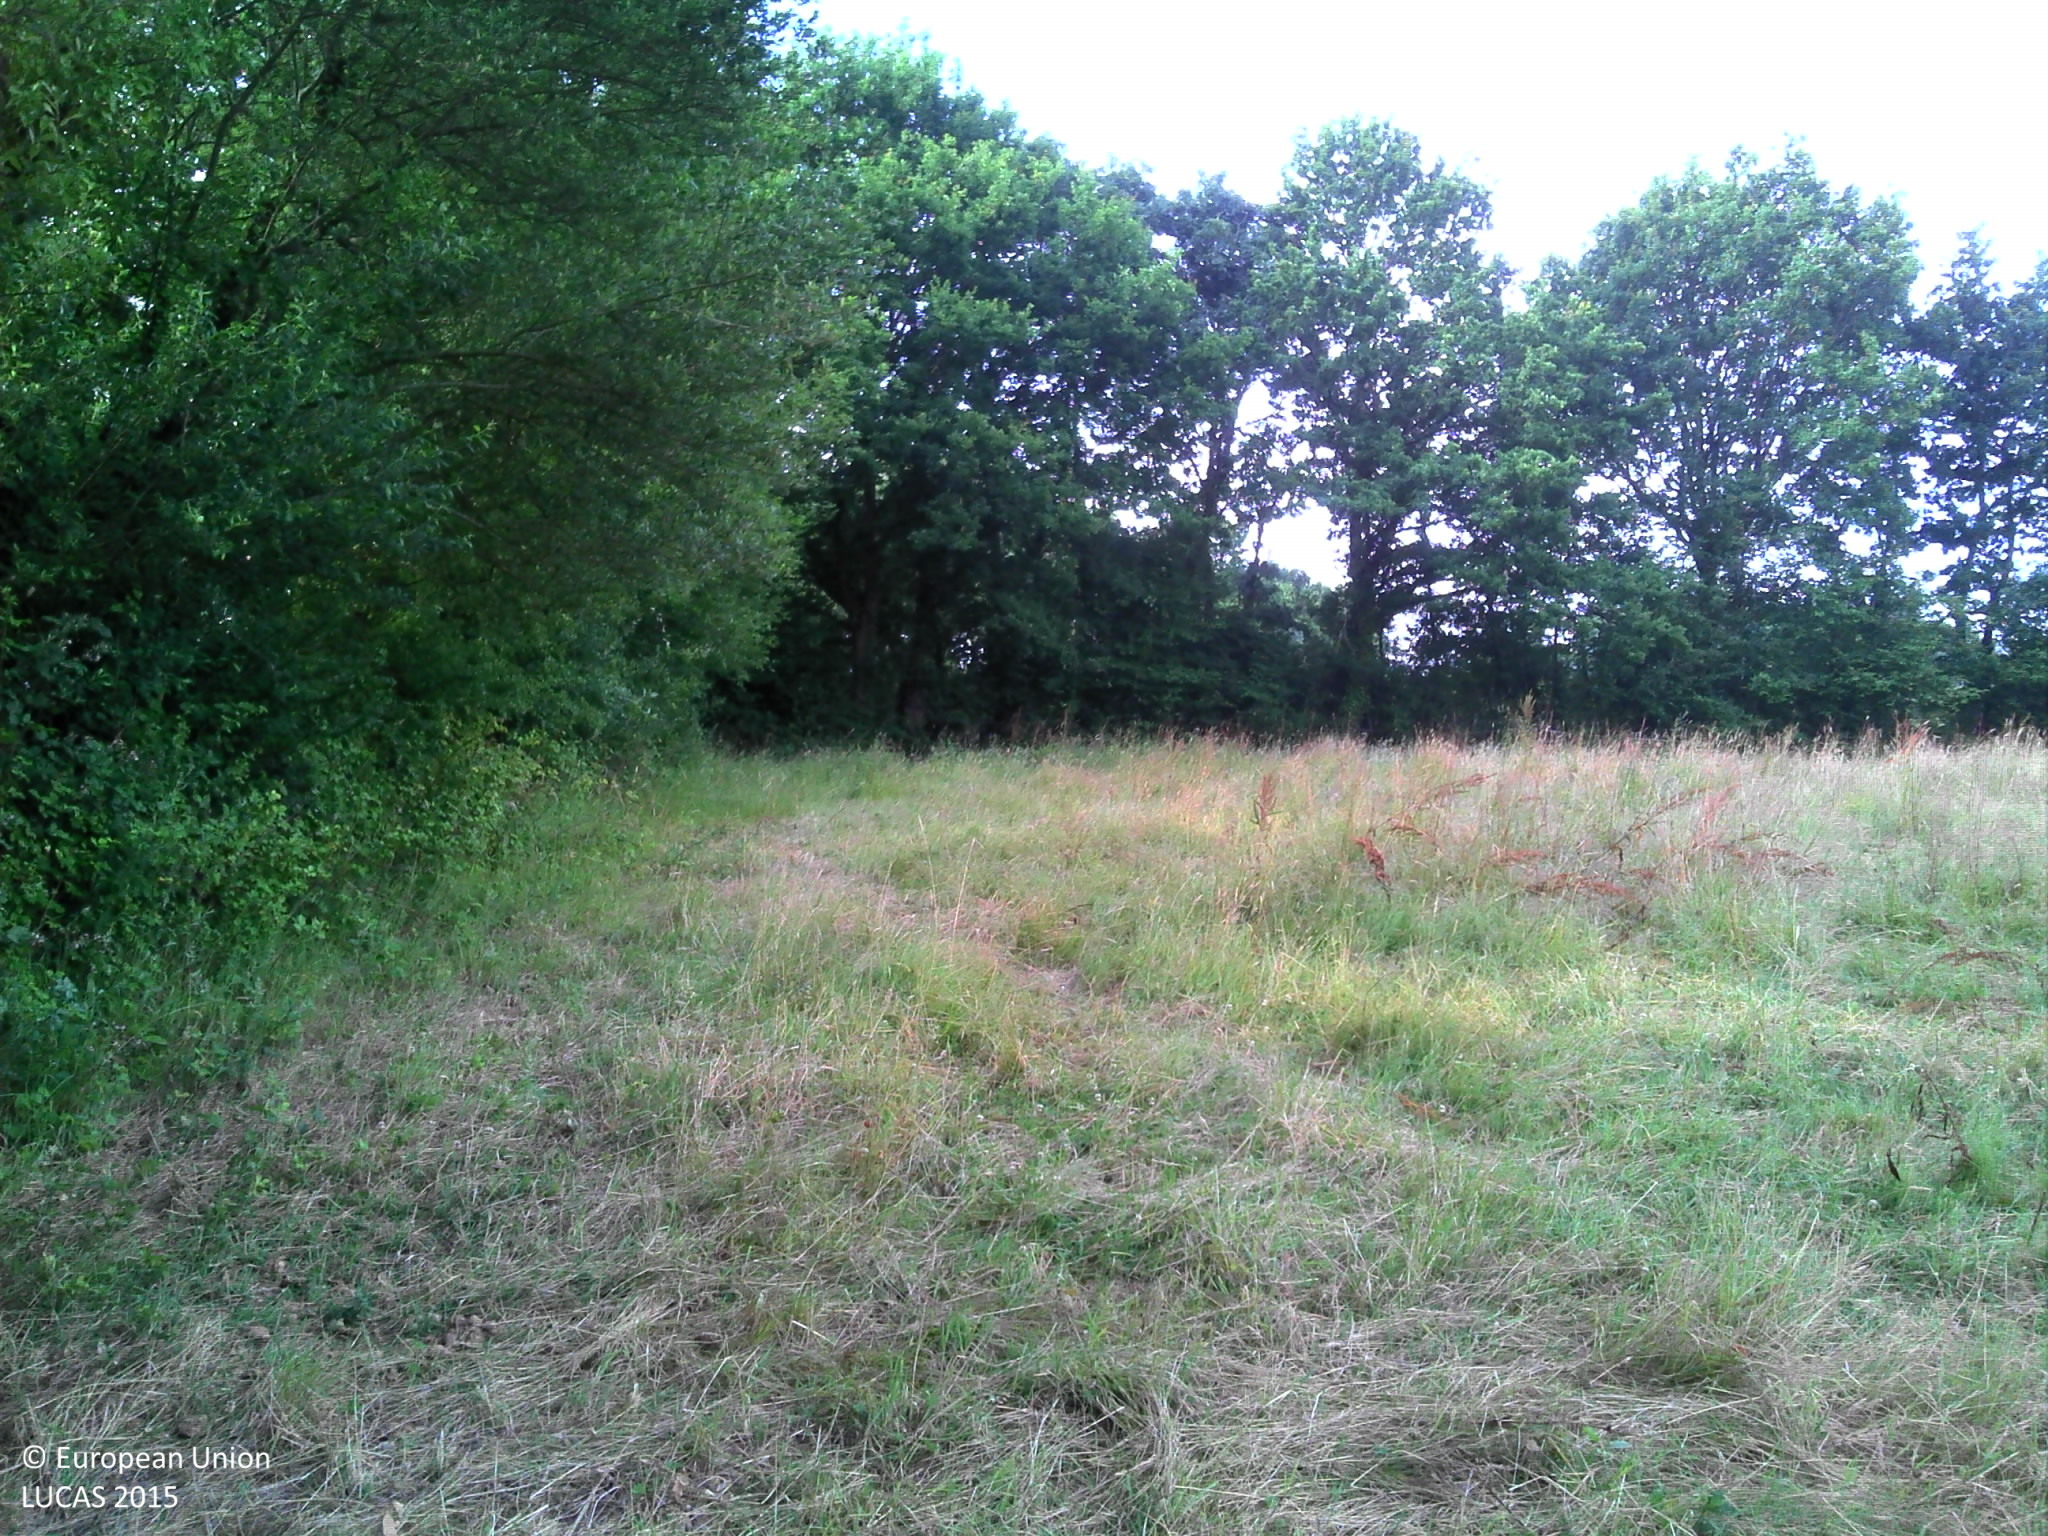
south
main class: Woodland
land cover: Broadleaved woodland
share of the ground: > 75 %
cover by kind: broadleaved forest trees 50 %, shrubs 40 %, herbaceous plants 10 %
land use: Agriculture (excluding fallow land and kitchen gardens)
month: June
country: FR
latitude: 47.3216
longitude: -1.5666
